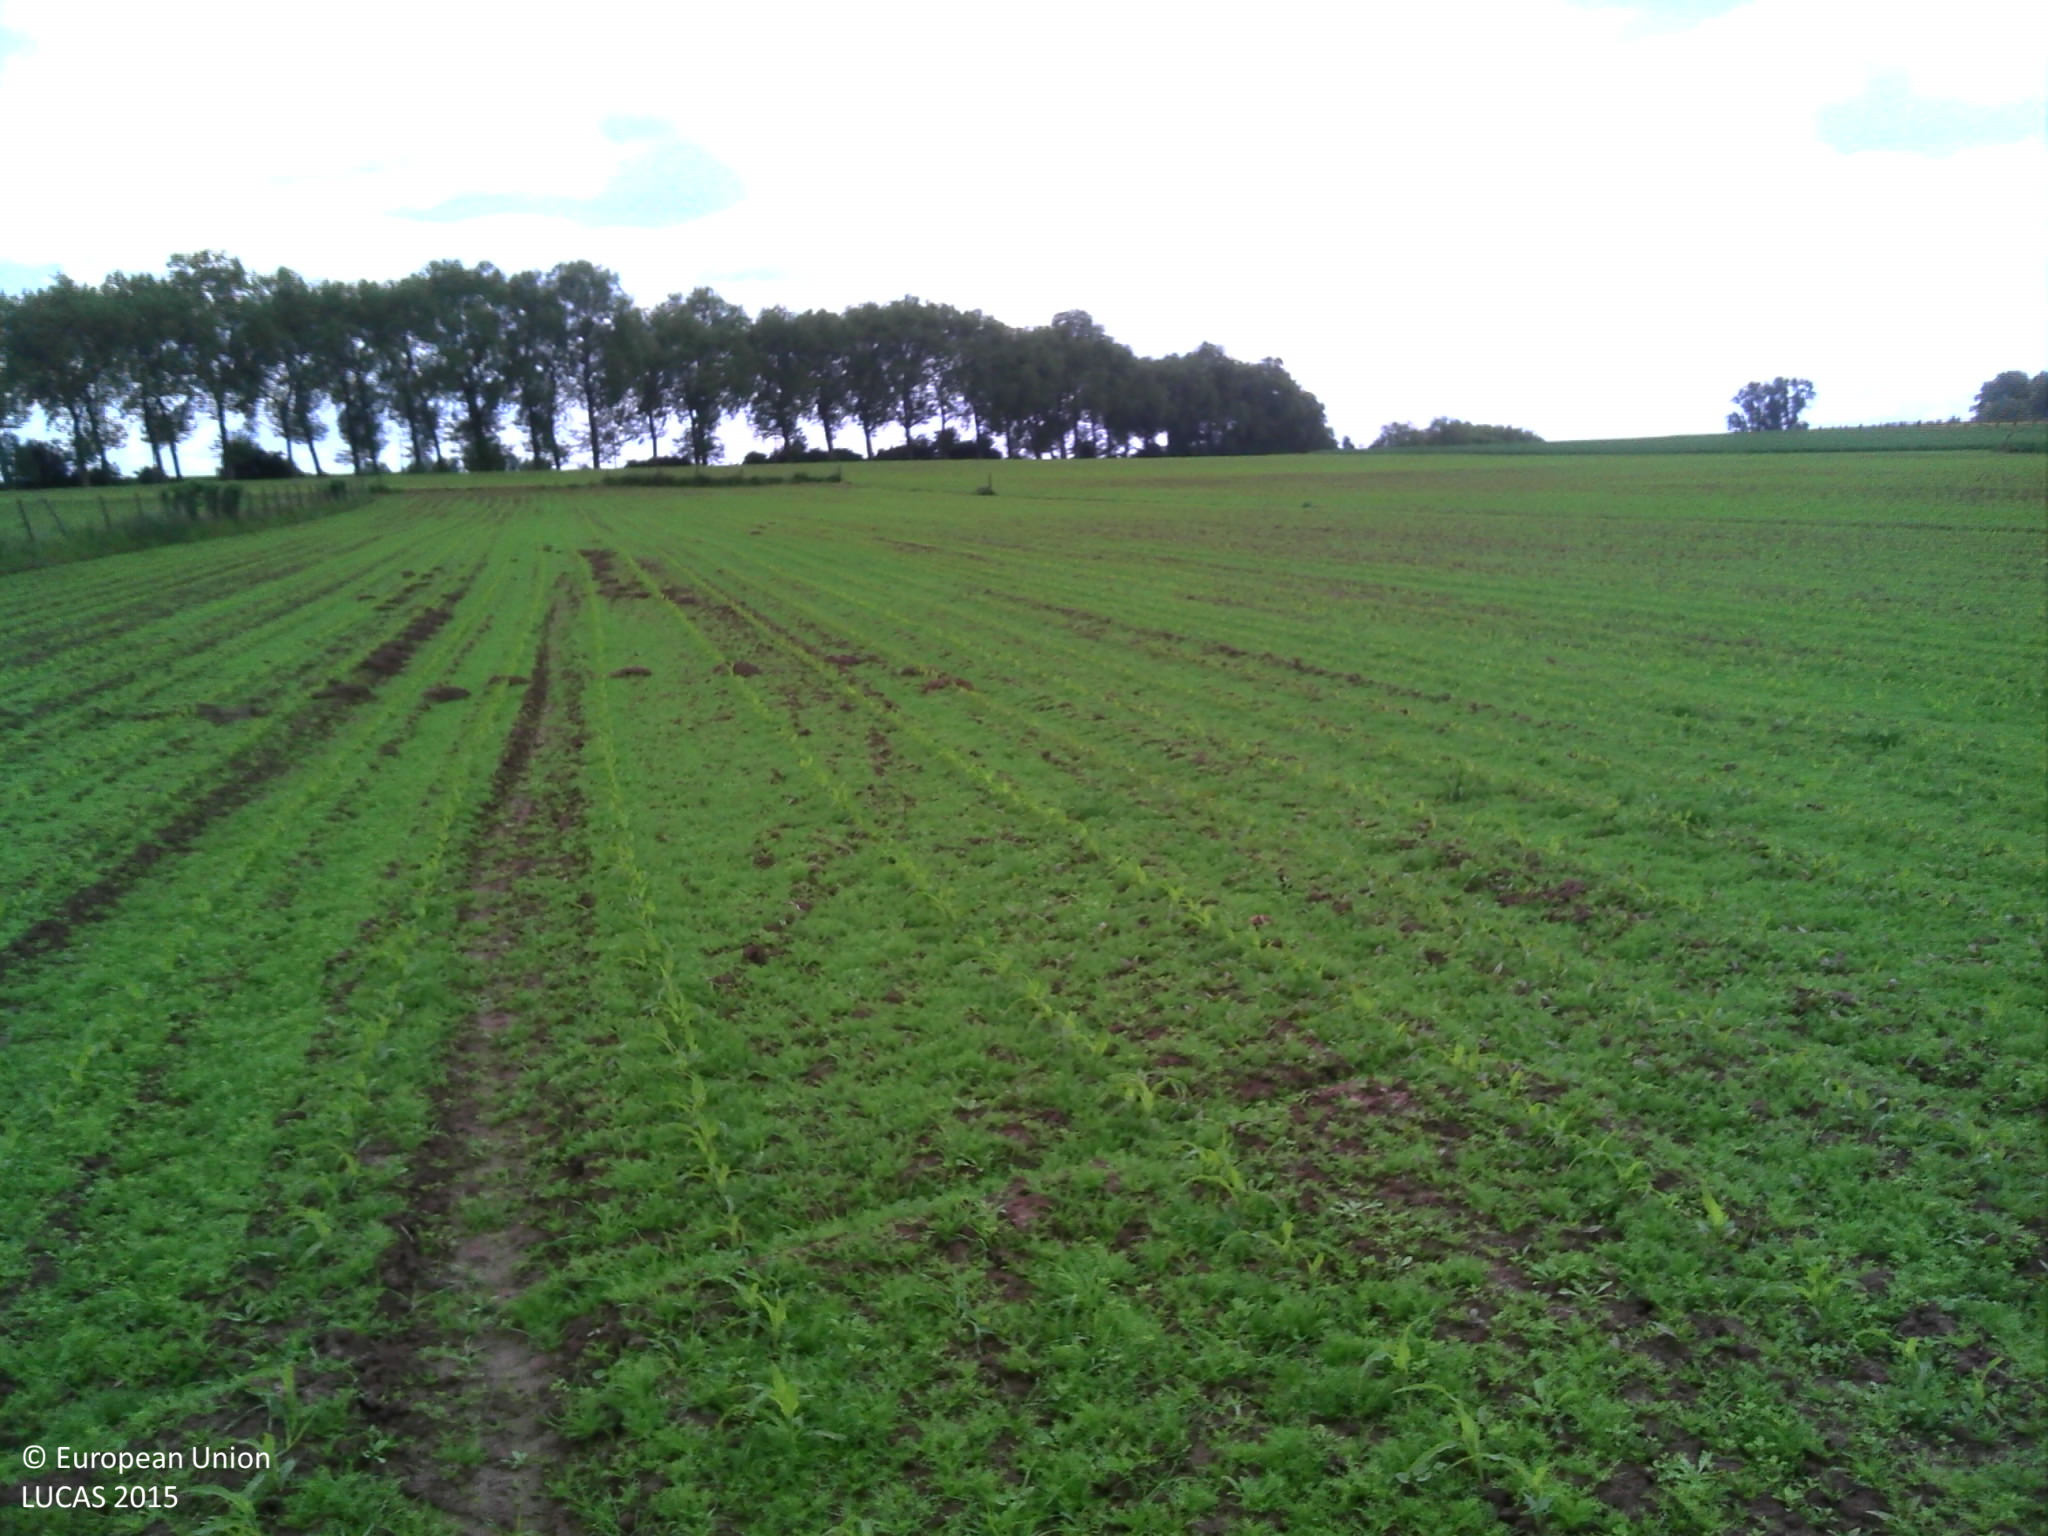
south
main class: Cropland
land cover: Maize
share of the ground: 10 - 25 %
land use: Agriculture (excluding fallow land and kitchen gardens)
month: June
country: BE
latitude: 50.8131
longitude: 3.8767
